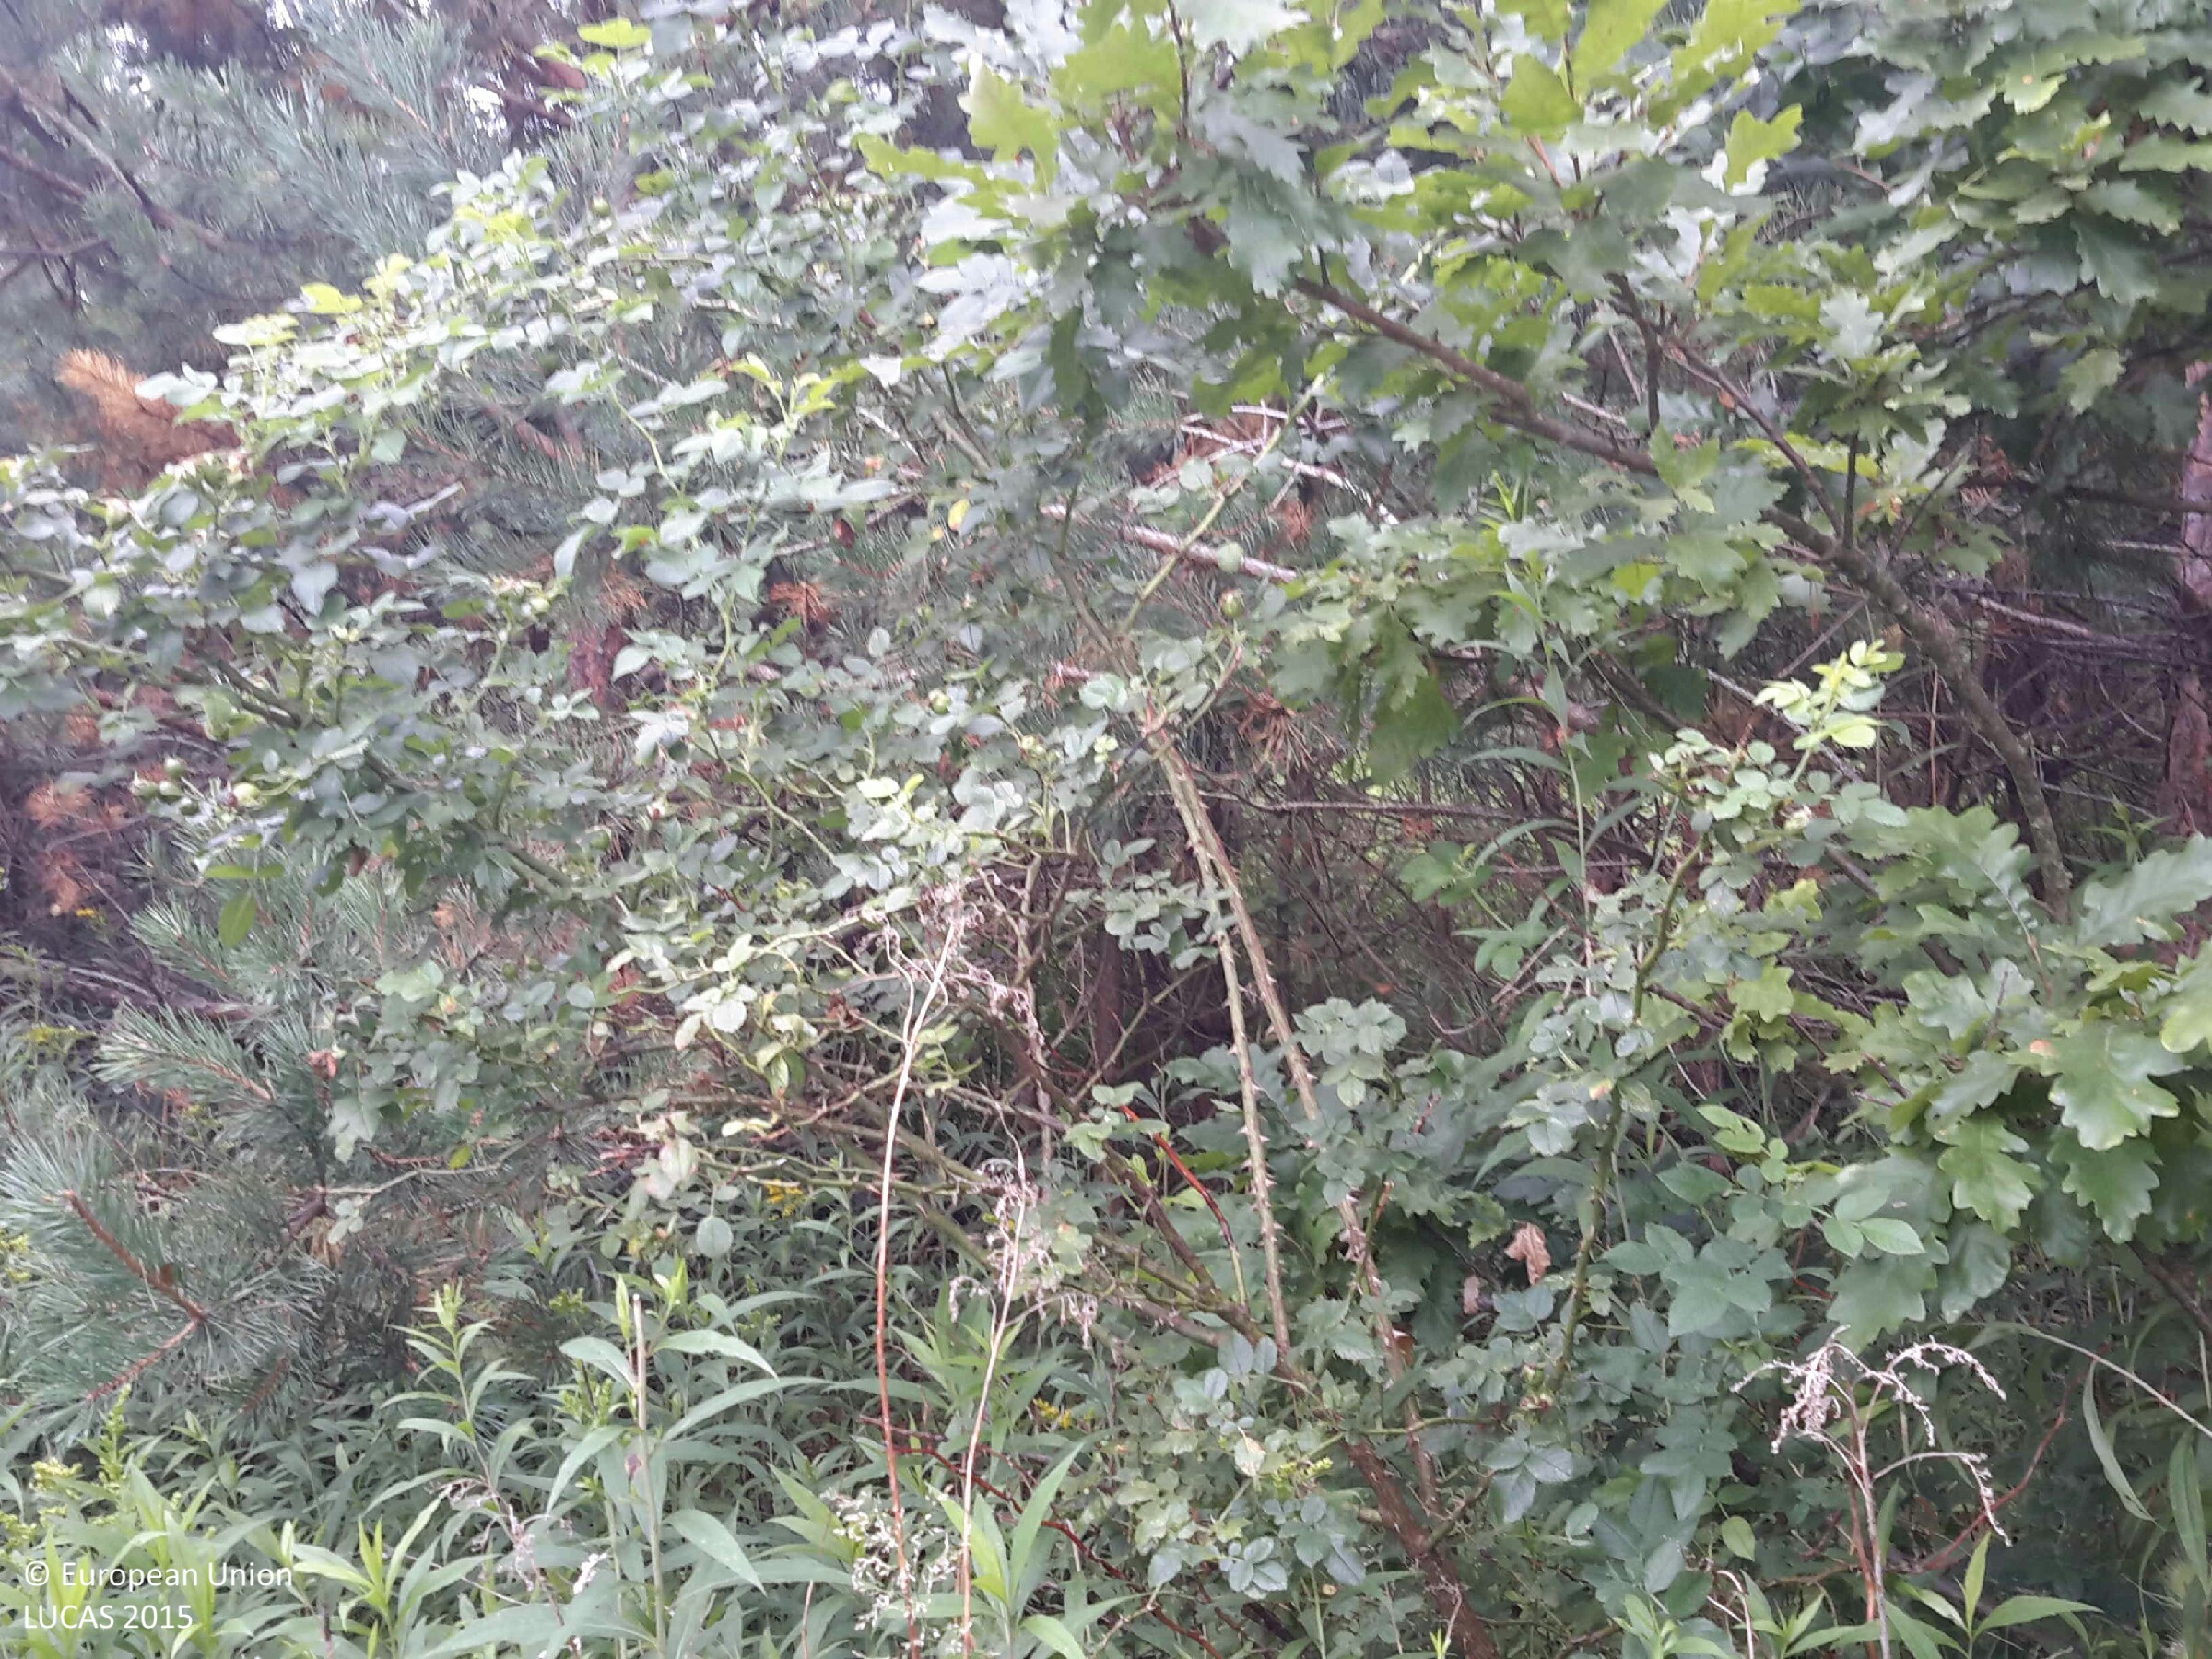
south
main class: Woodland
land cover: Pine dominated coniferous woodland
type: hemiboreal forest and nemoral coniferous forest and mixed broadleaved-coniferous forest
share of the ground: 25 - 50 %
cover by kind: coniferous forest trees 50 %, herbaceous plants 40 %, broadleaved forest trees 10 %
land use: Forestry
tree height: > 5 m
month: July
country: HU
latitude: 47.2020
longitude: 16.4846
